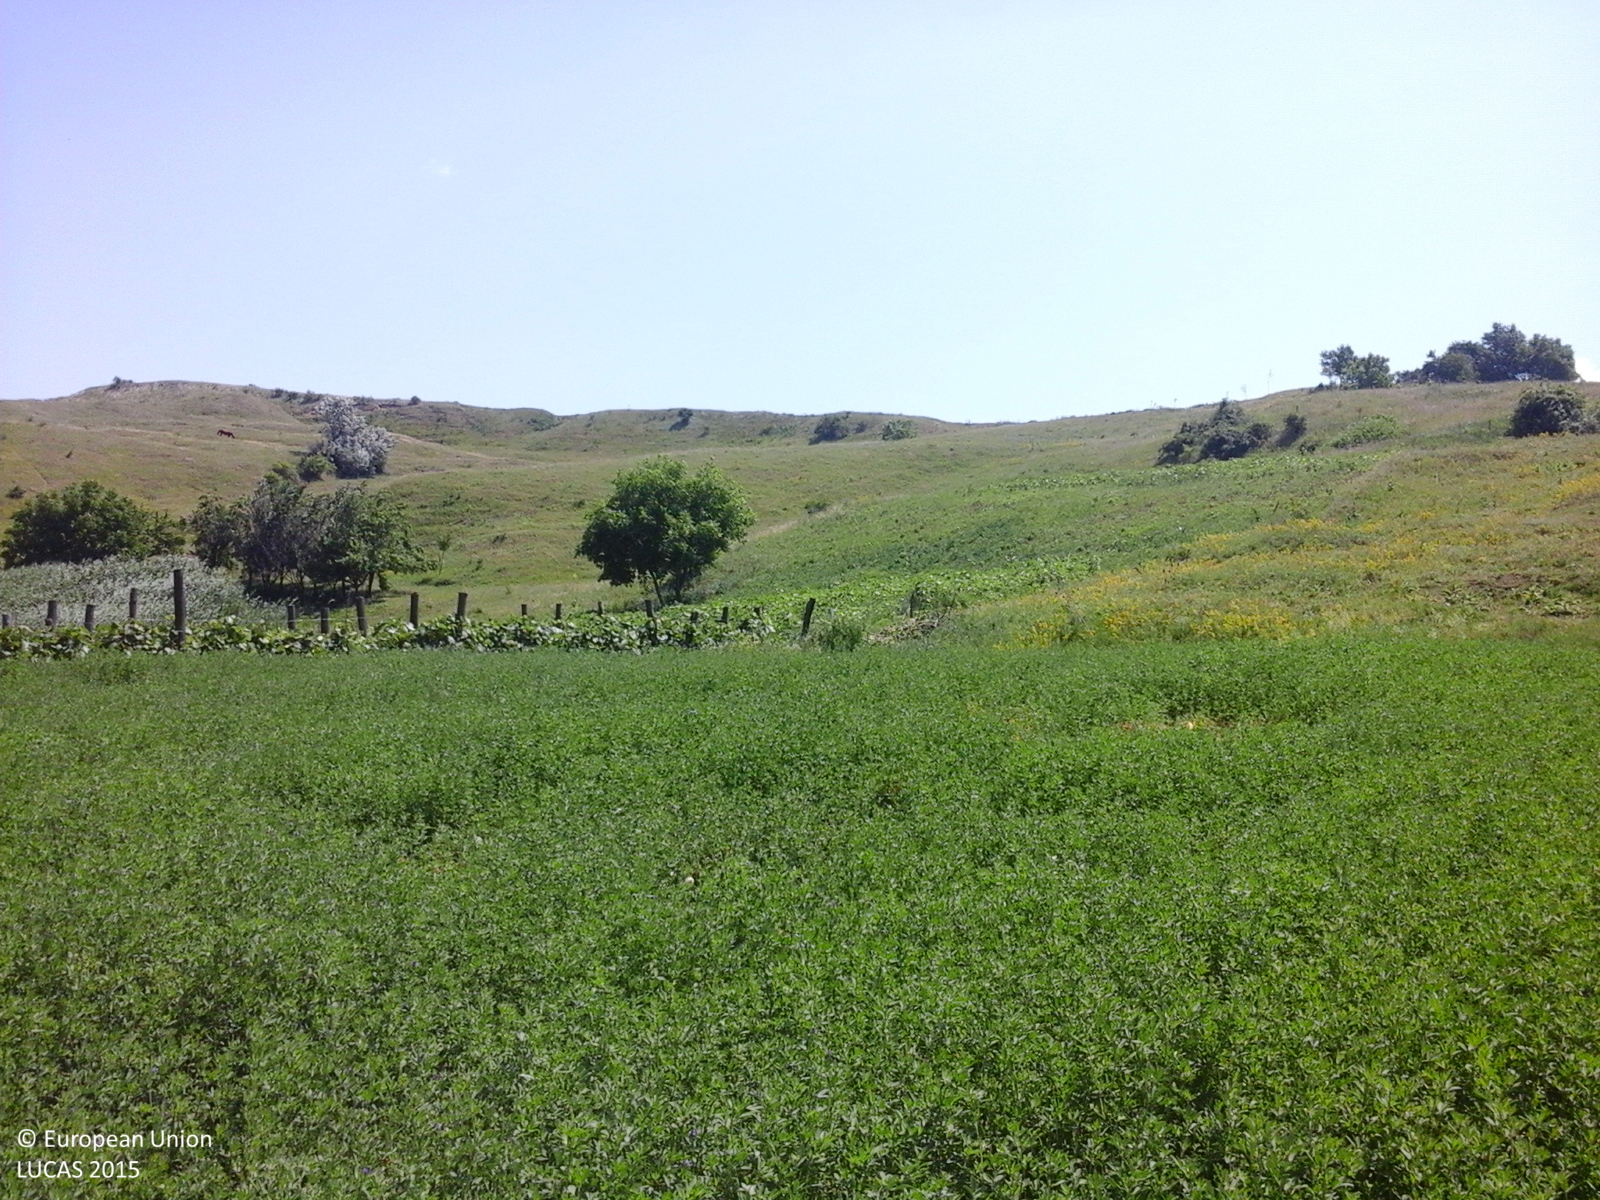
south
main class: Cropland
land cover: Lucerne
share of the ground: > 75 %
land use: Agriculture (excluding fallow land and kitchen gardens)
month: June
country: RO
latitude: 46.7946
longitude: 27.3630
